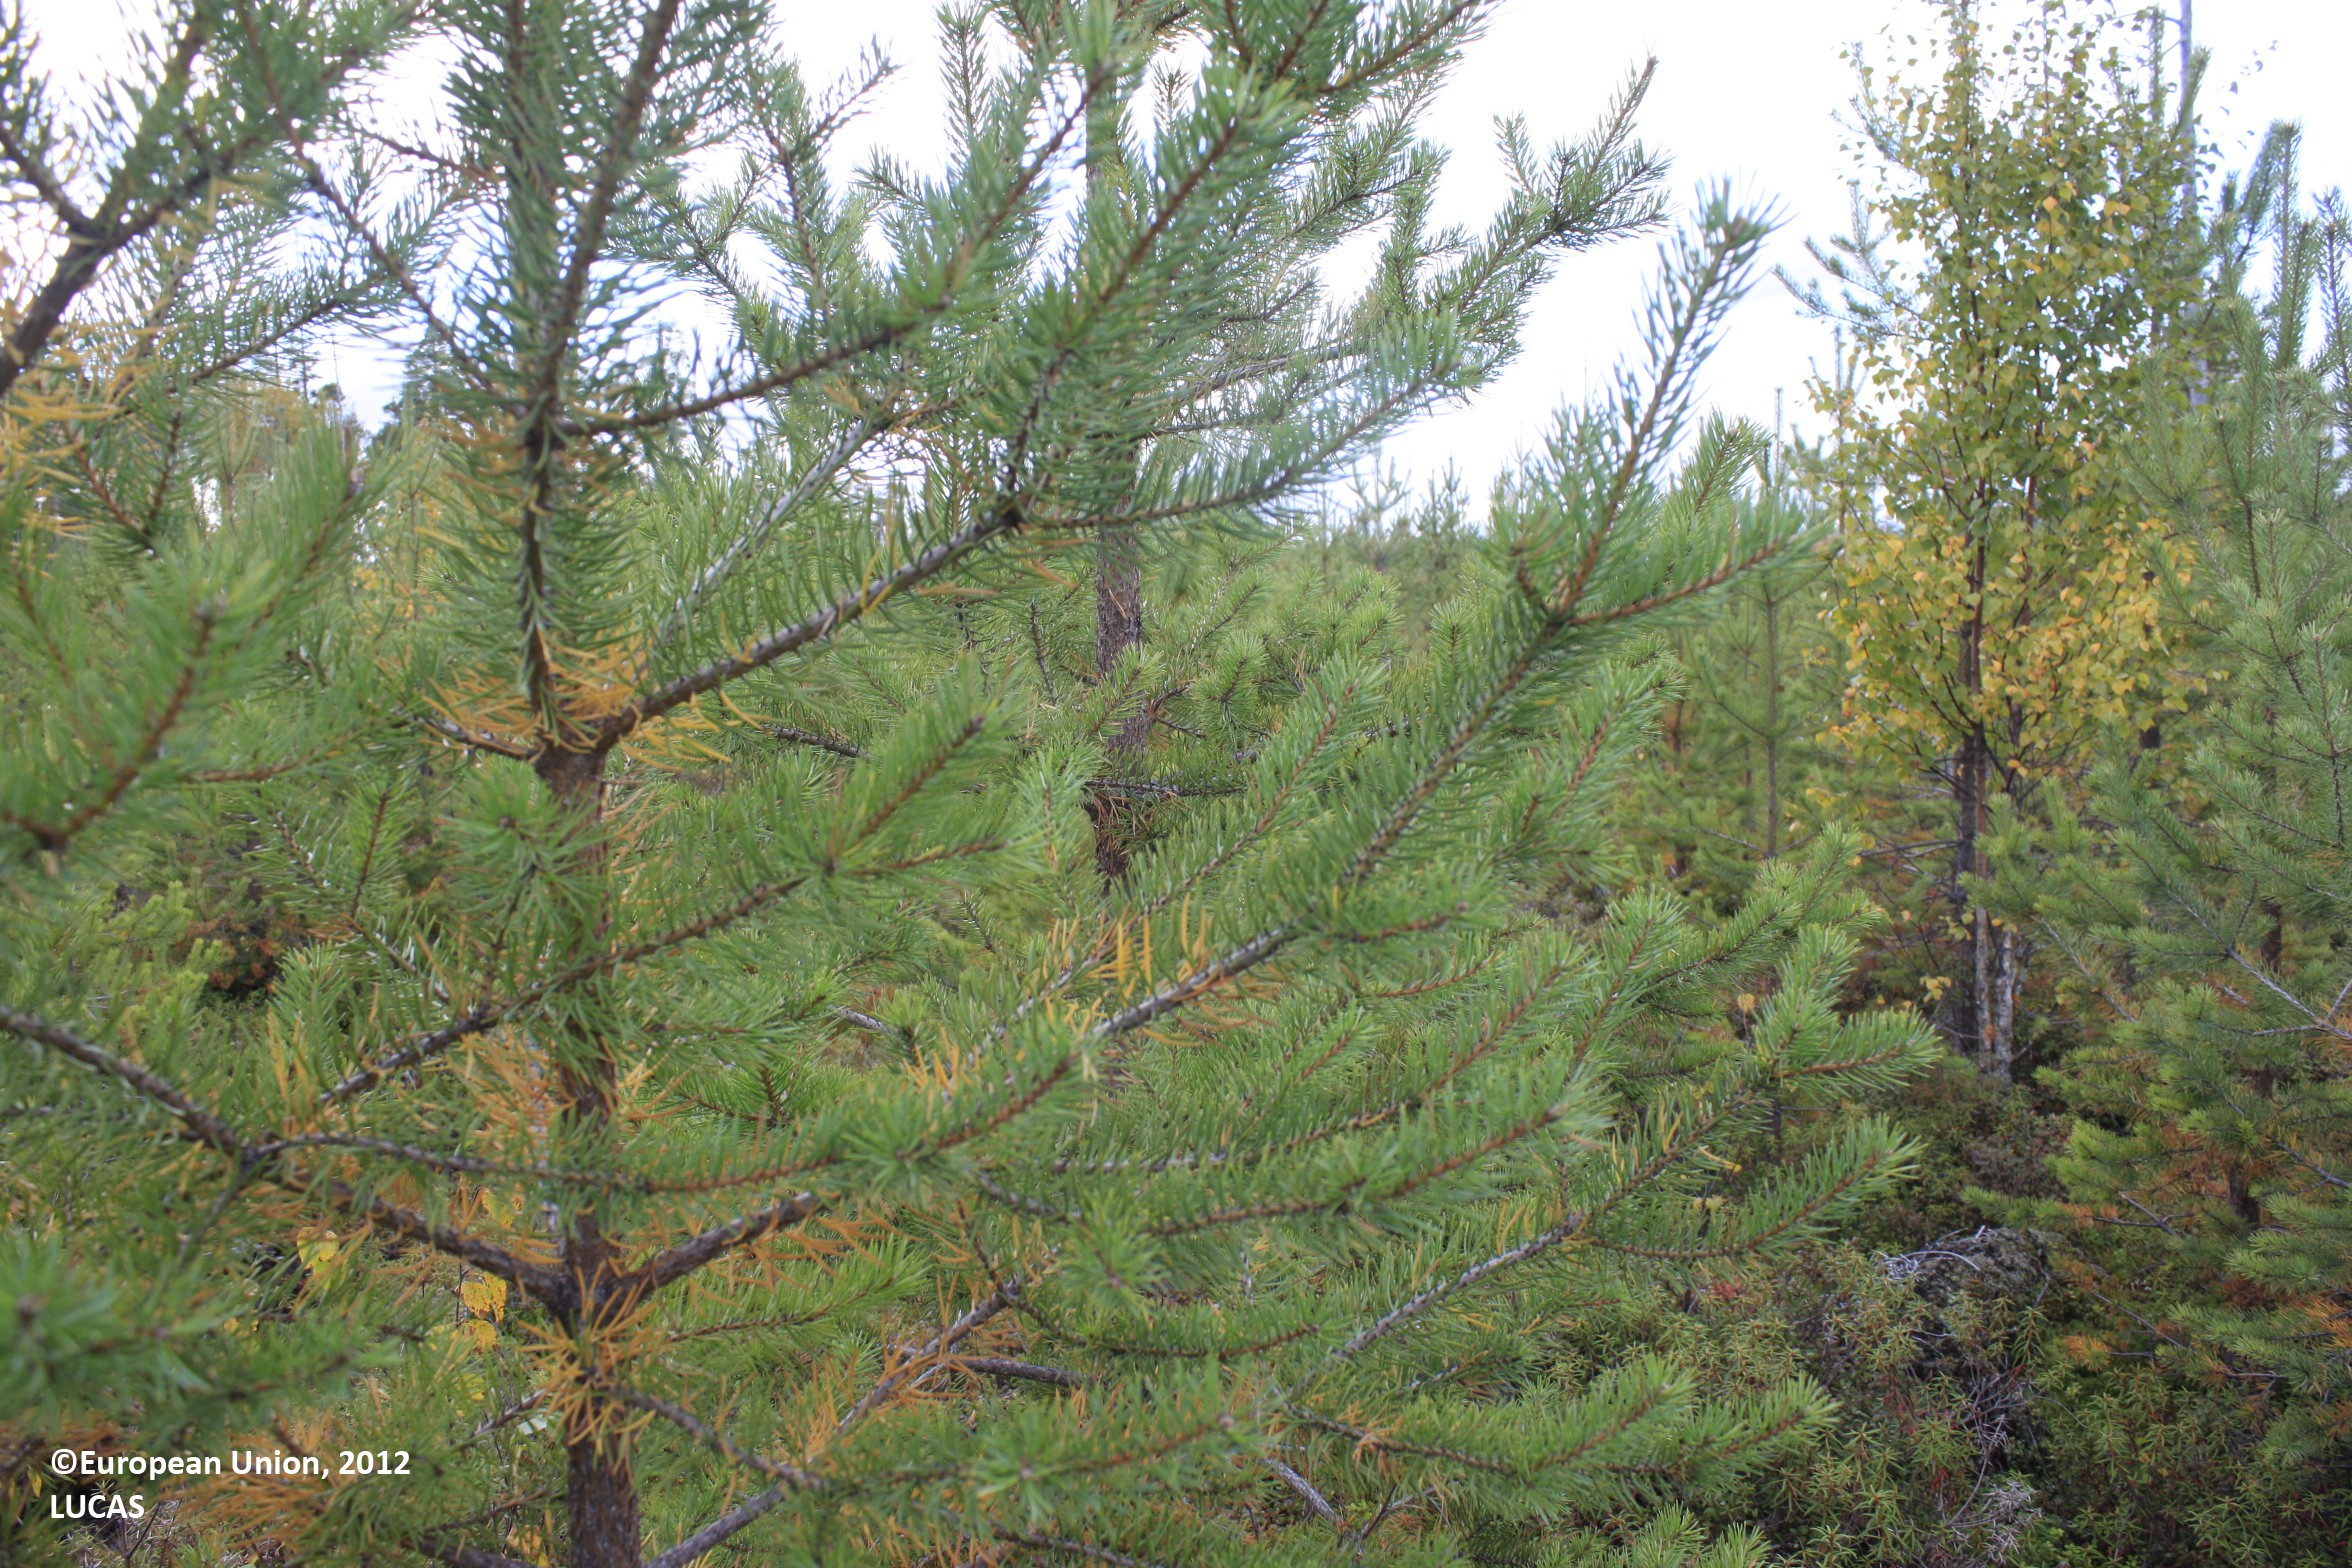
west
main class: Woodland
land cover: Pine dominated coniferous woodland
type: boreal forest
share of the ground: 50 - 75 %
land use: Forestry
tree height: < 5 m
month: September
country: FI
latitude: 65.4320
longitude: 27.0820
